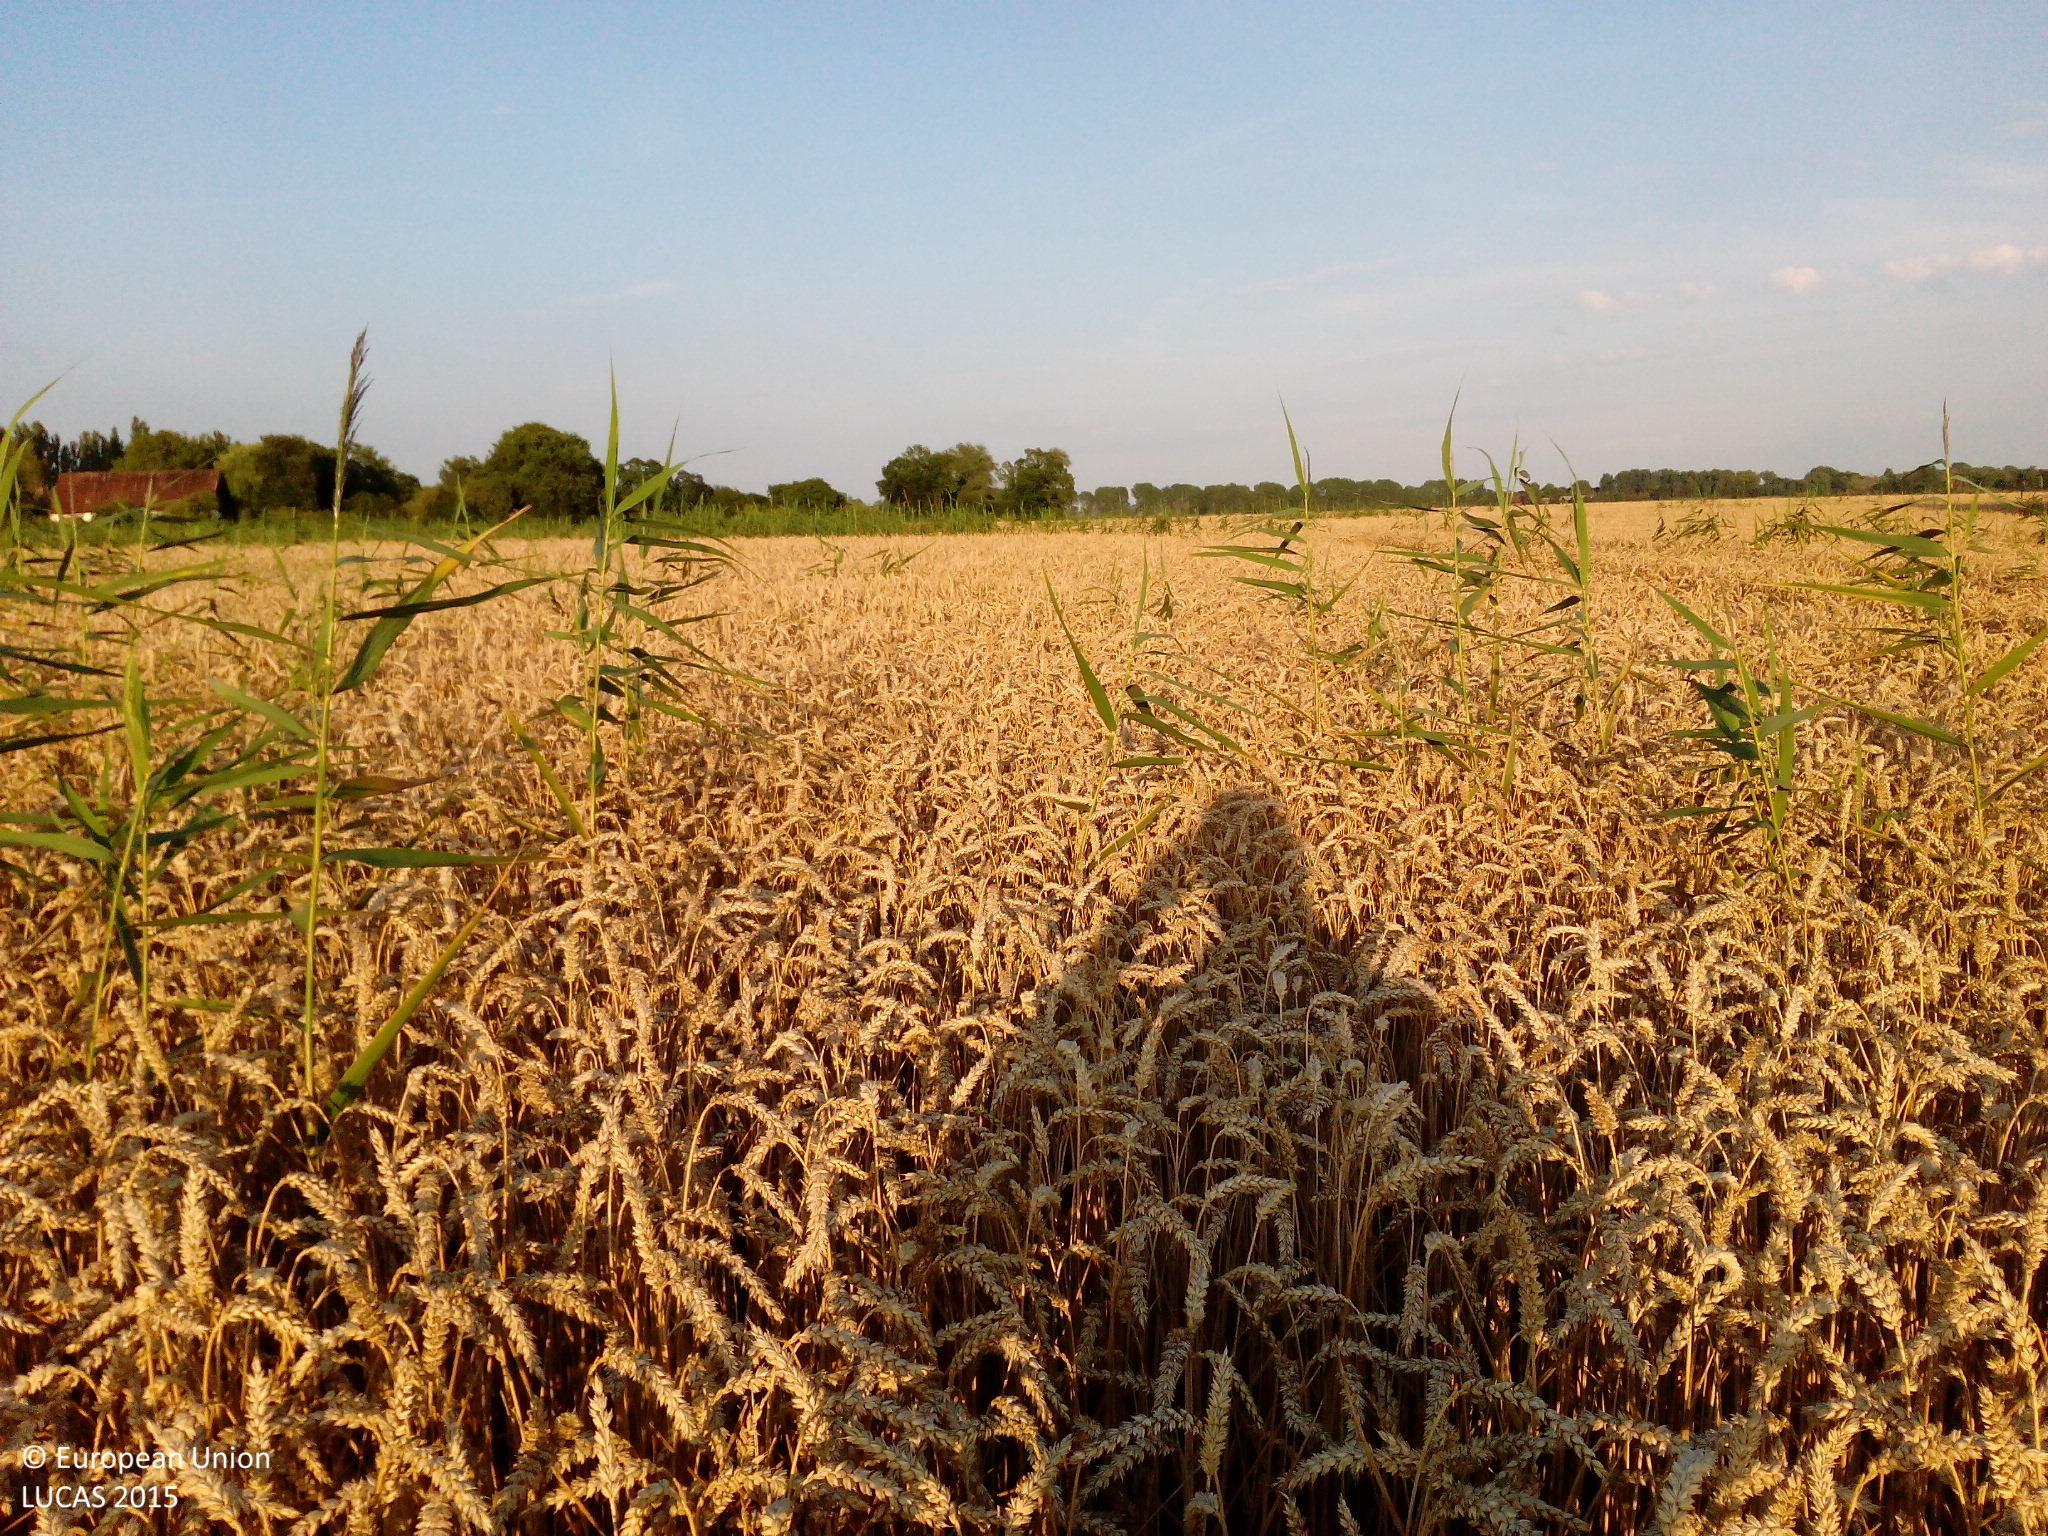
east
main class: Cropland
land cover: Common wheat
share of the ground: > 75 %
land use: Agriculture (excluding fallow land and kitchen gardens)
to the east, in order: Common wheat
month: July
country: DE
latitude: 52.7524
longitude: 14.2235
